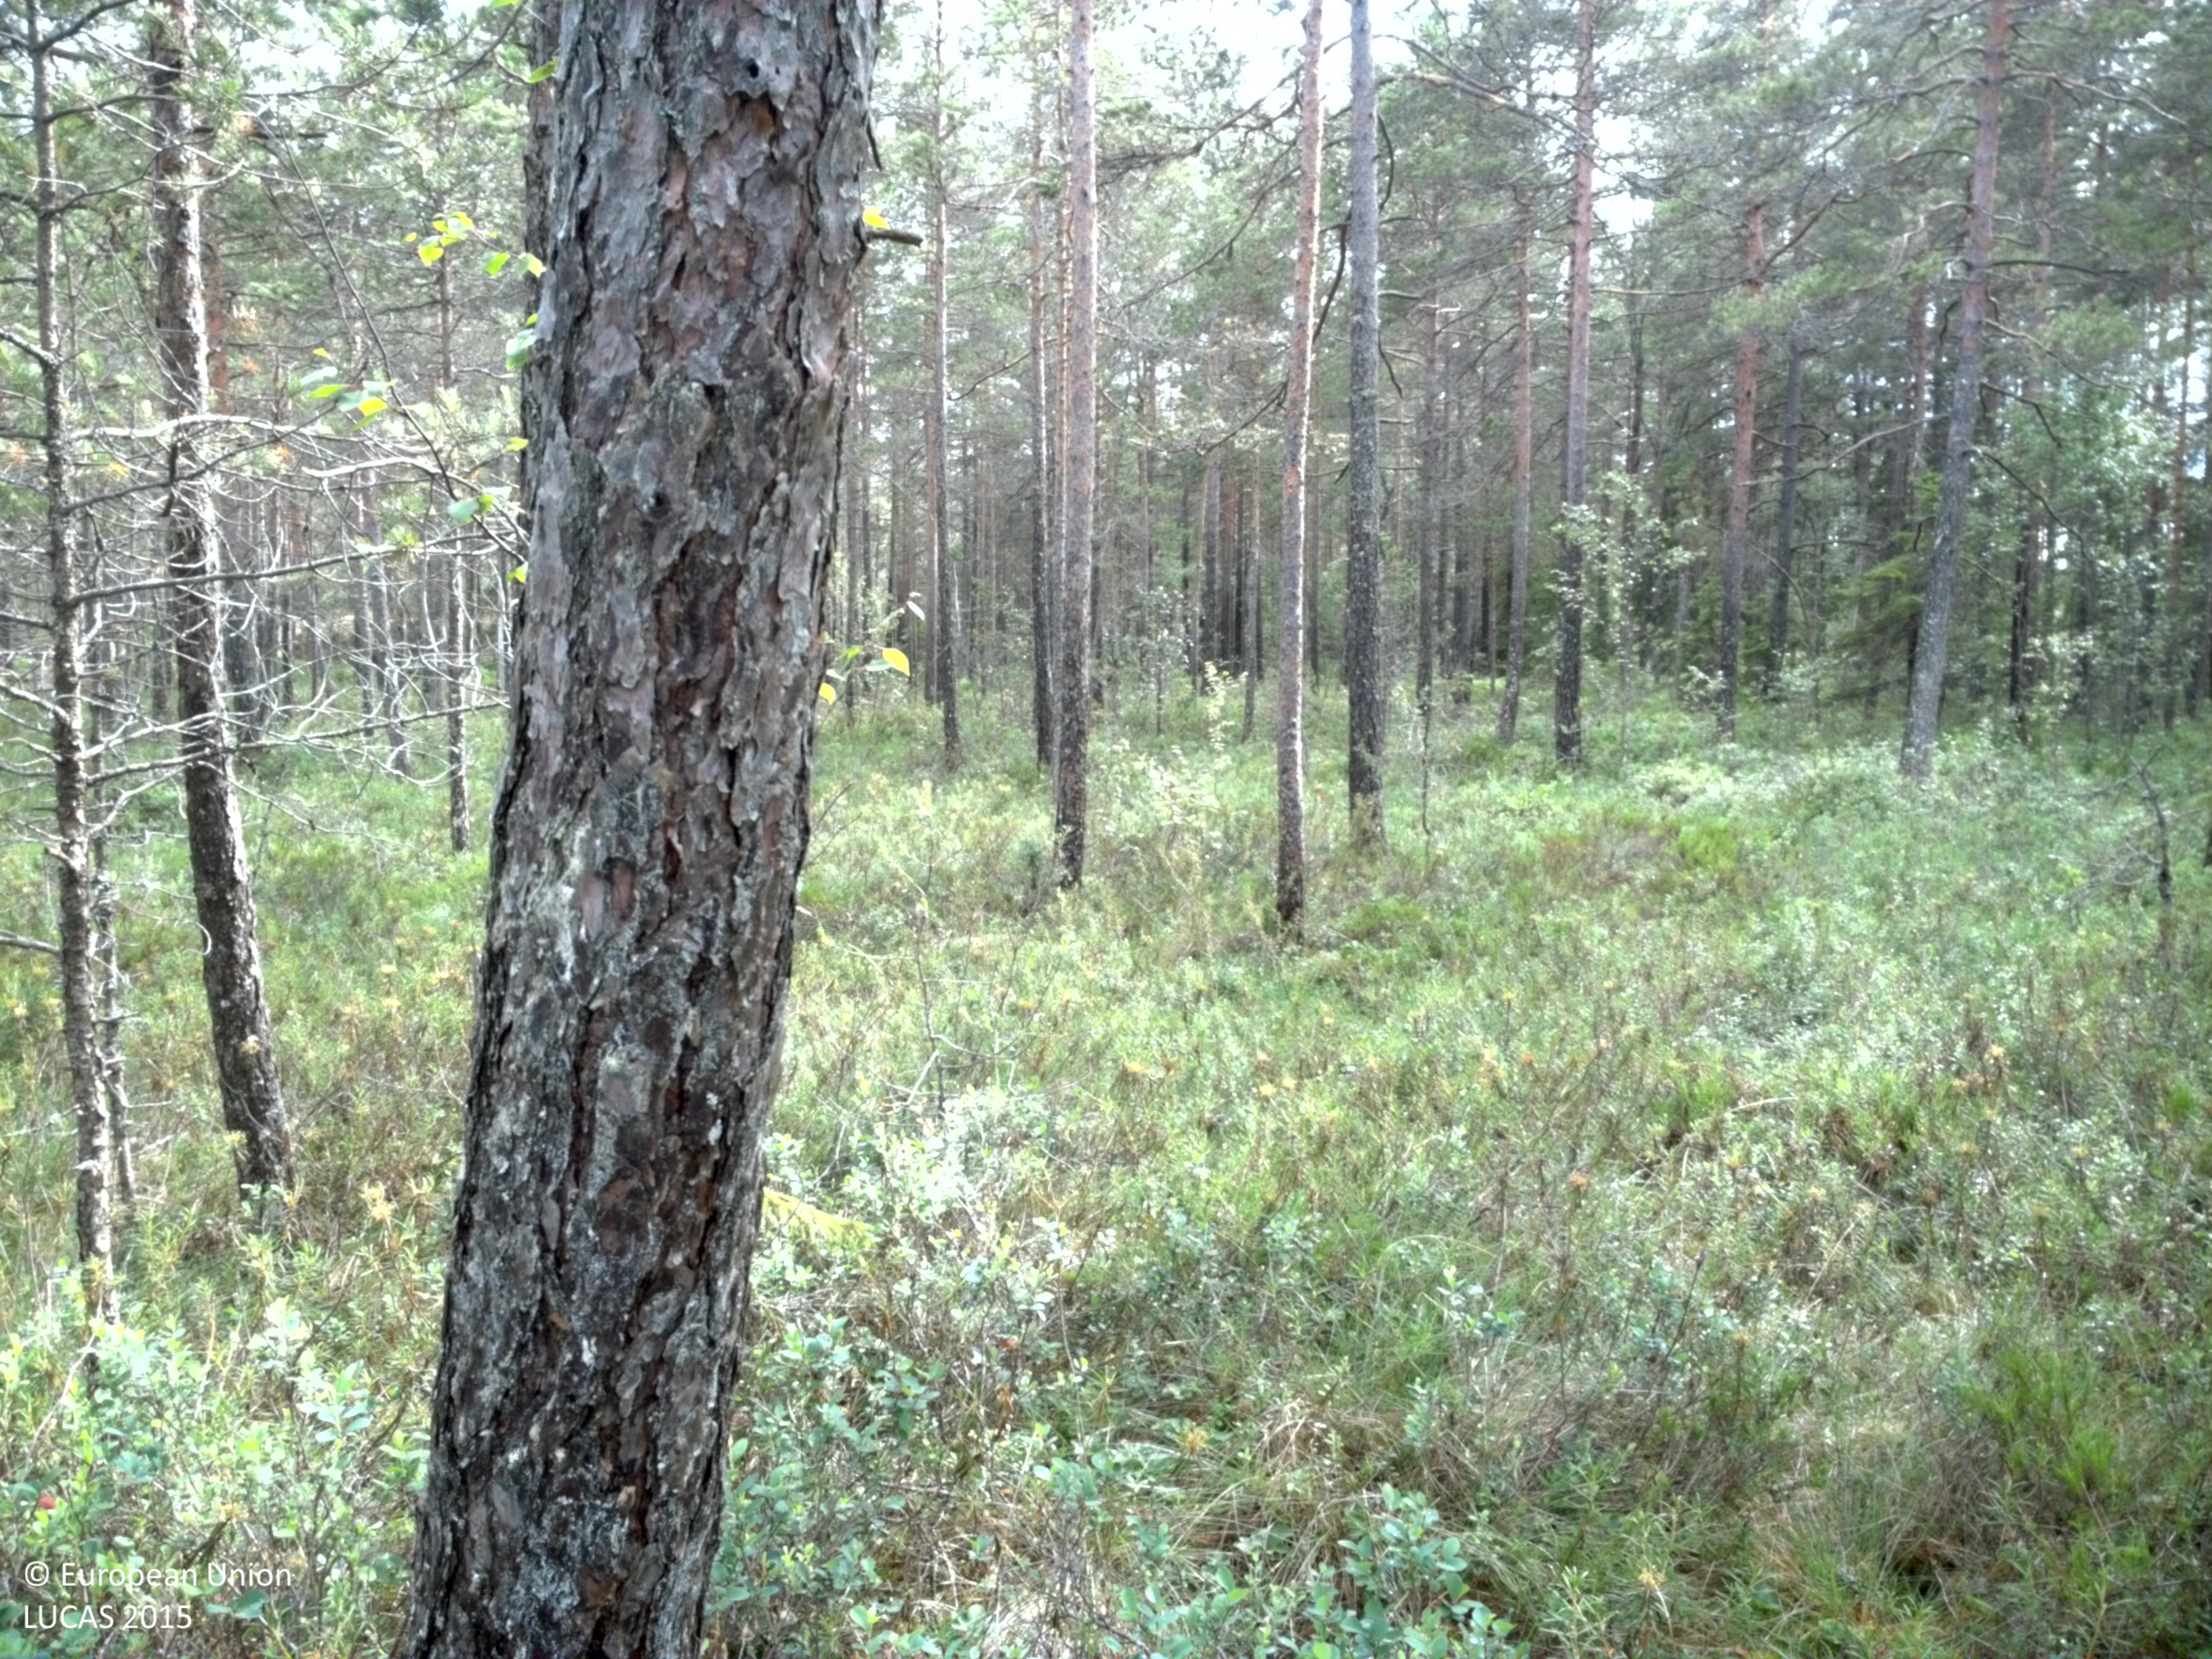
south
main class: Woodland
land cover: Pine dominated mixed woodland
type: mire and swamp forests
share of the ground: 50 - 75 %
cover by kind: coniferous forest trees 50 %, broadleaved forest trees 20 %, shrubs 20 %, herbaceous plants 5 %, lichens and mosses 5 %
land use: Forestry
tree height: > 5 m
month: July
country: SE
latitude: 59.4711
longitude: 14.7033
